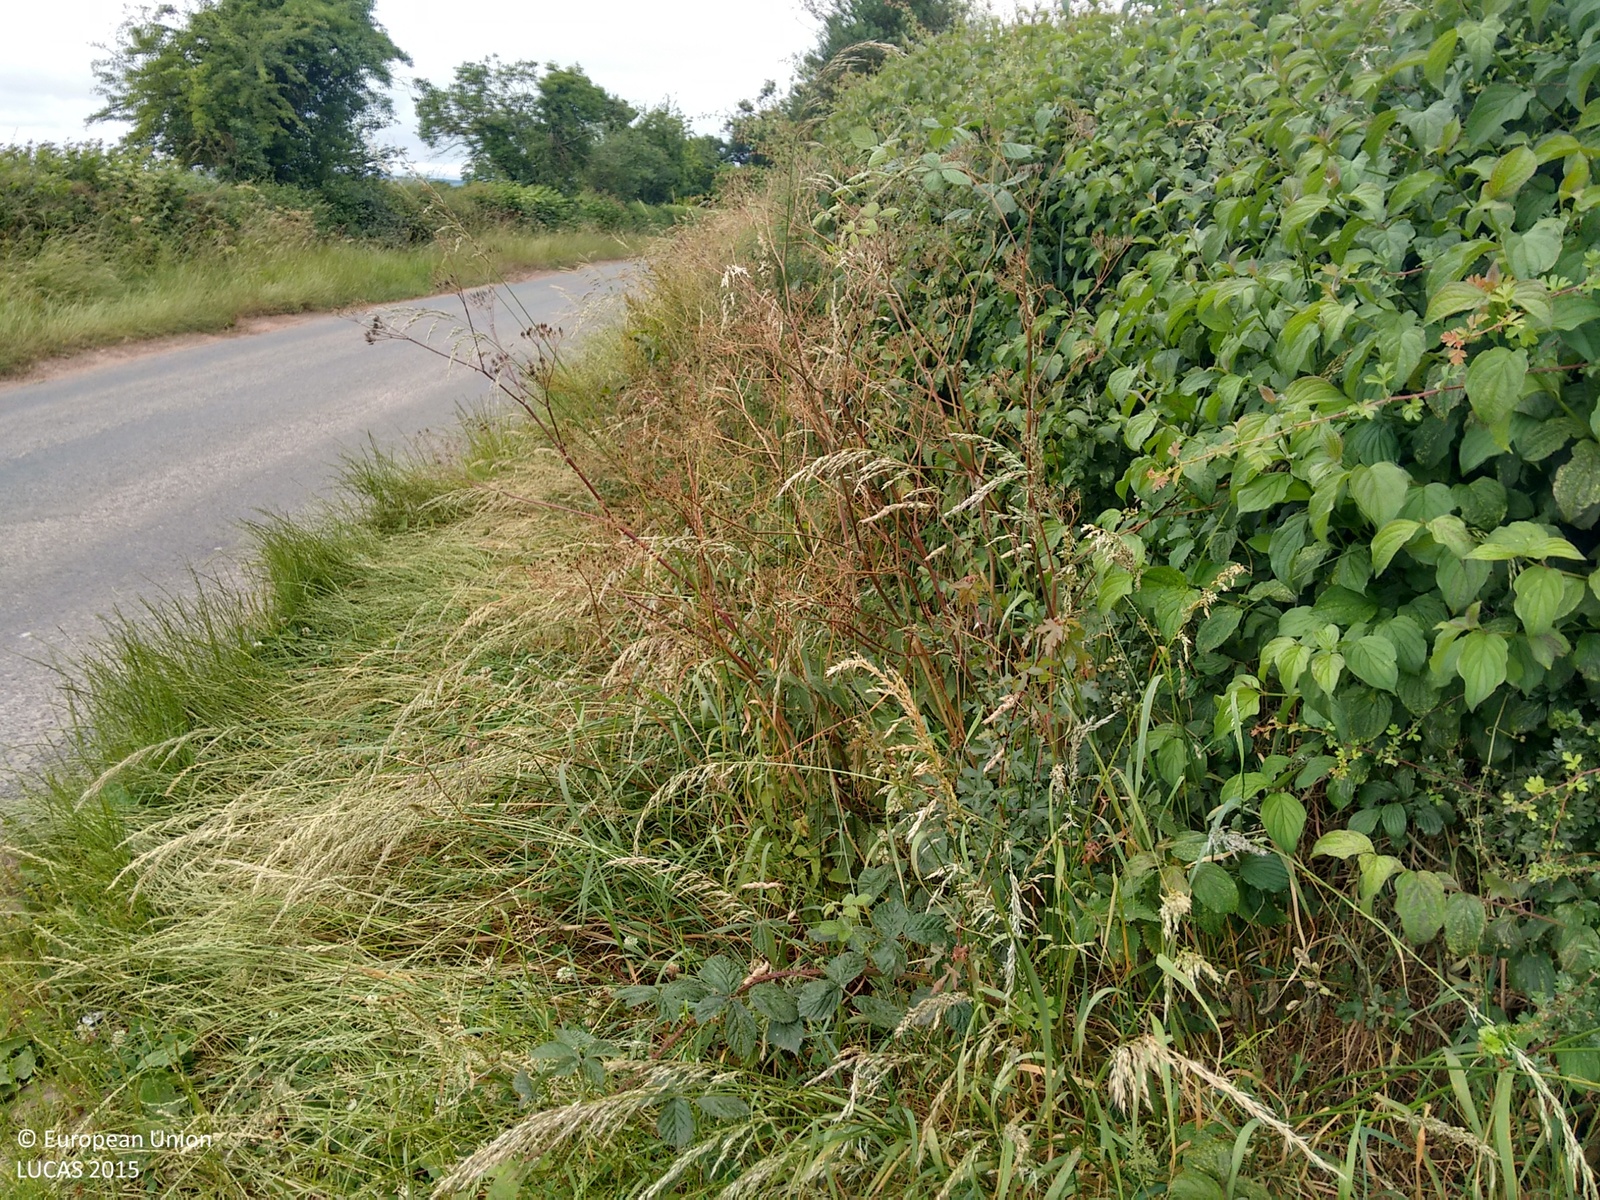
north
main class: Cropland
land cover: Barley
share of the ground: > 75 %
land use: Agriculture (excluding fallow land and kitchen gardens)
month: July
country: GB
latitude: 52.2373
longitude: -2.7073
